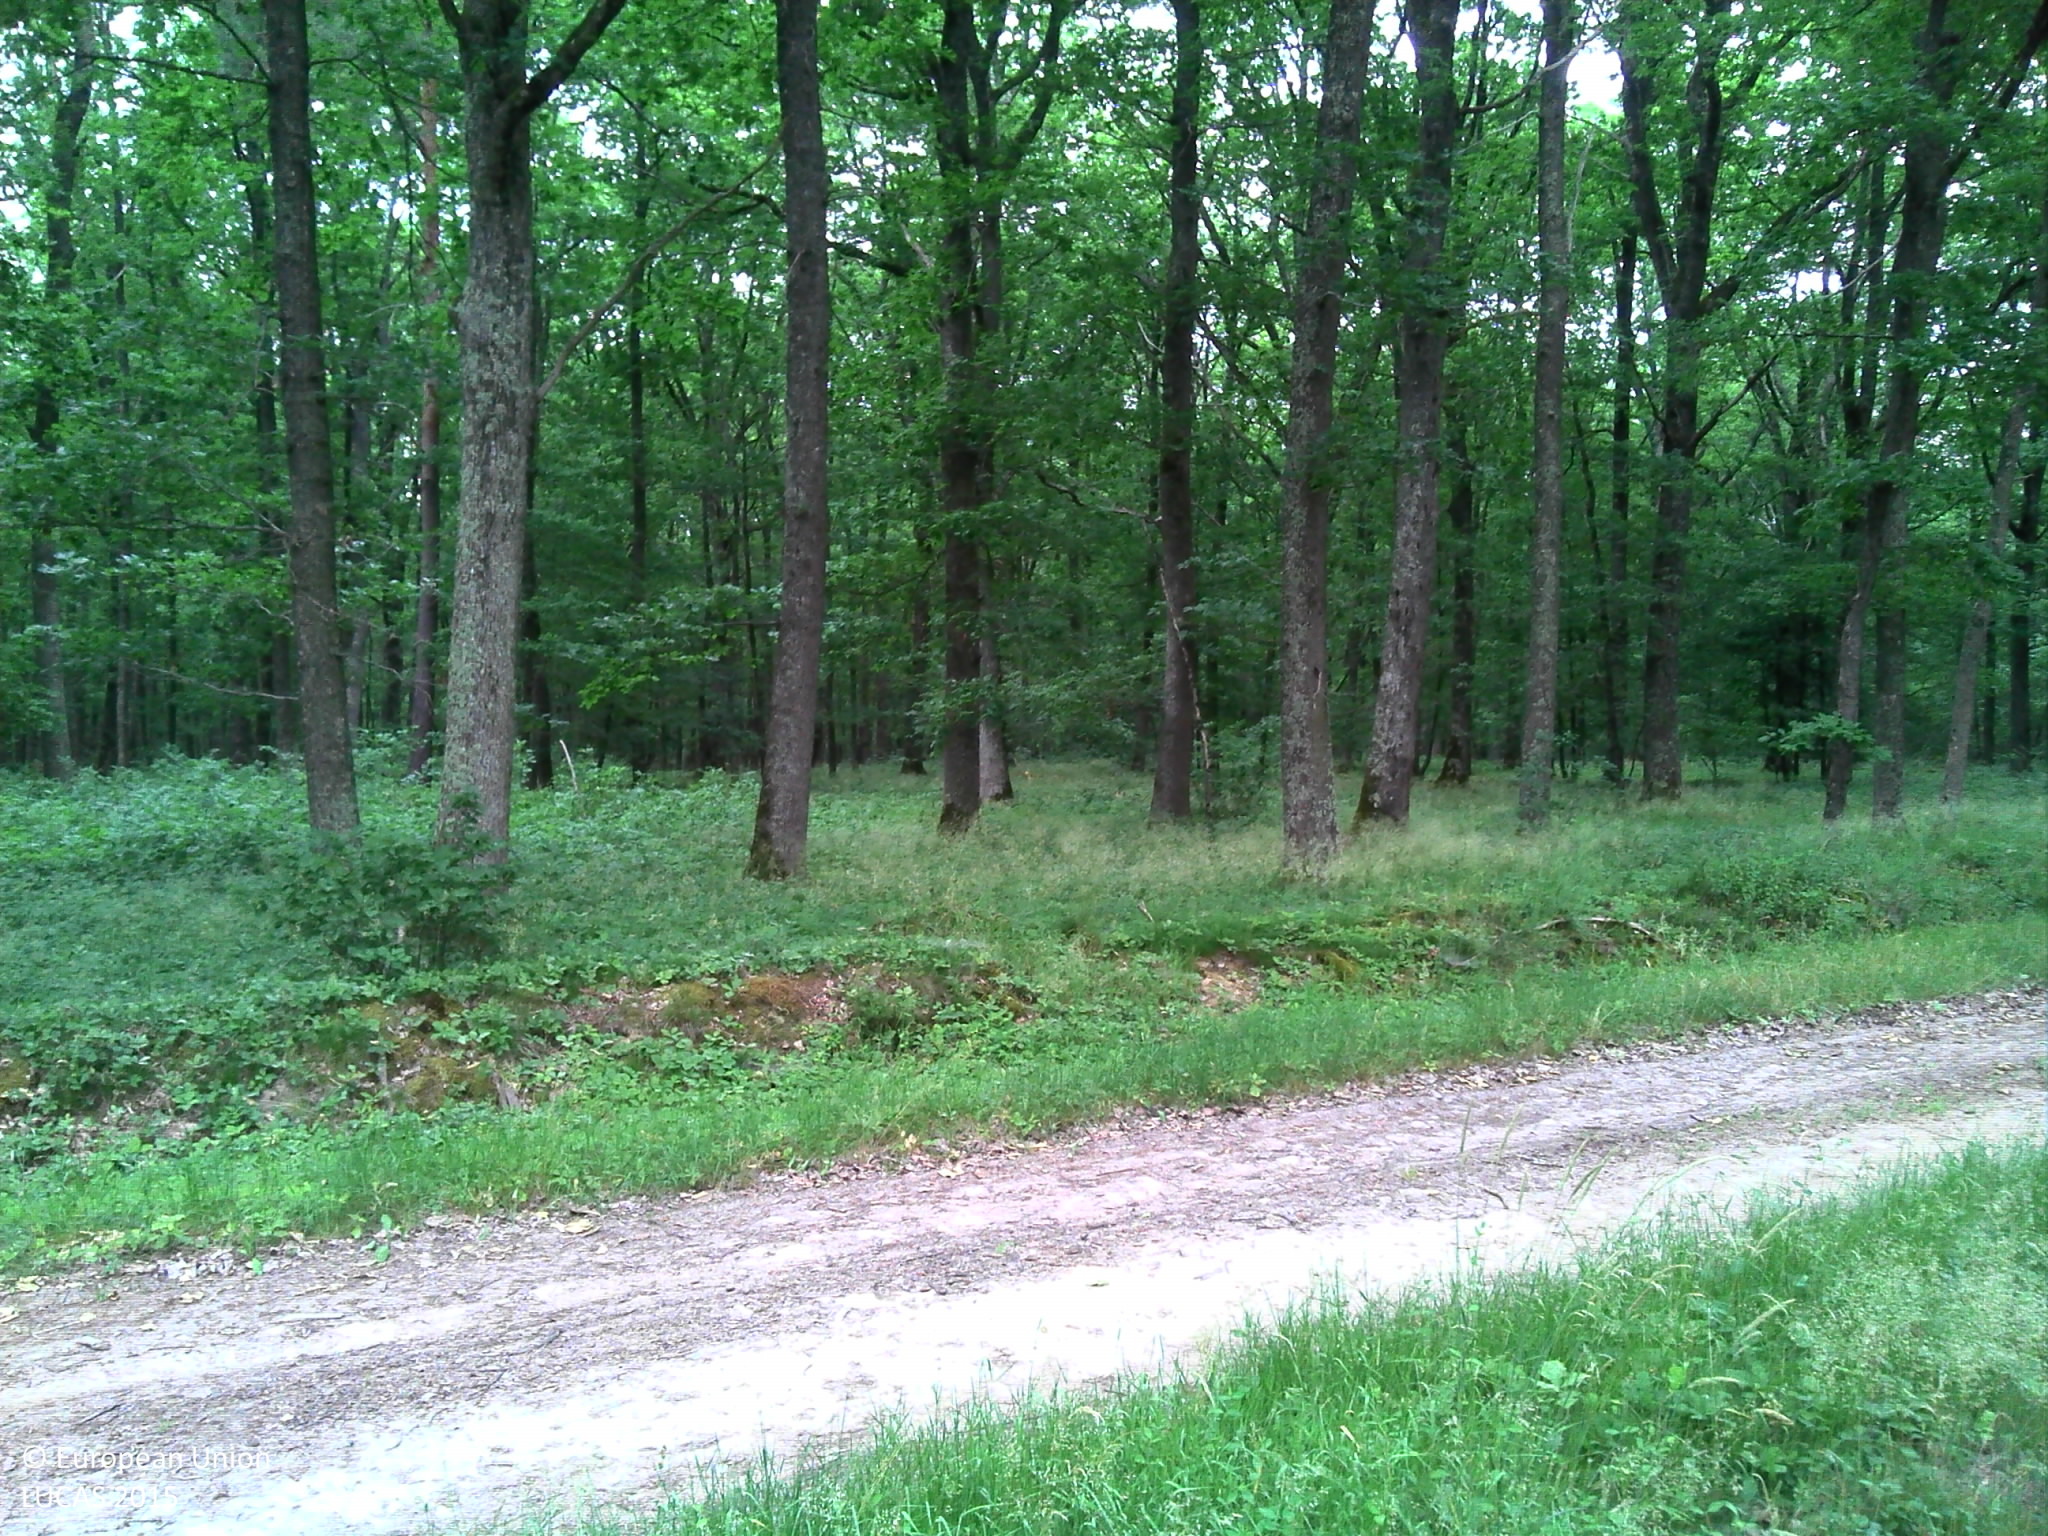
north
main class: Woodland
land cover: Broadleaved woodland
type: acidophilous oak and oak-birch forest
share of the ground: > 75 %
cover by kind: broadleaved forest trees 90 %, herbaceous plants 10 %
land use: Forestry
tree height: > 5 m
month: June
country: FR
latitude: 46.3962
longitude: 2.7785
